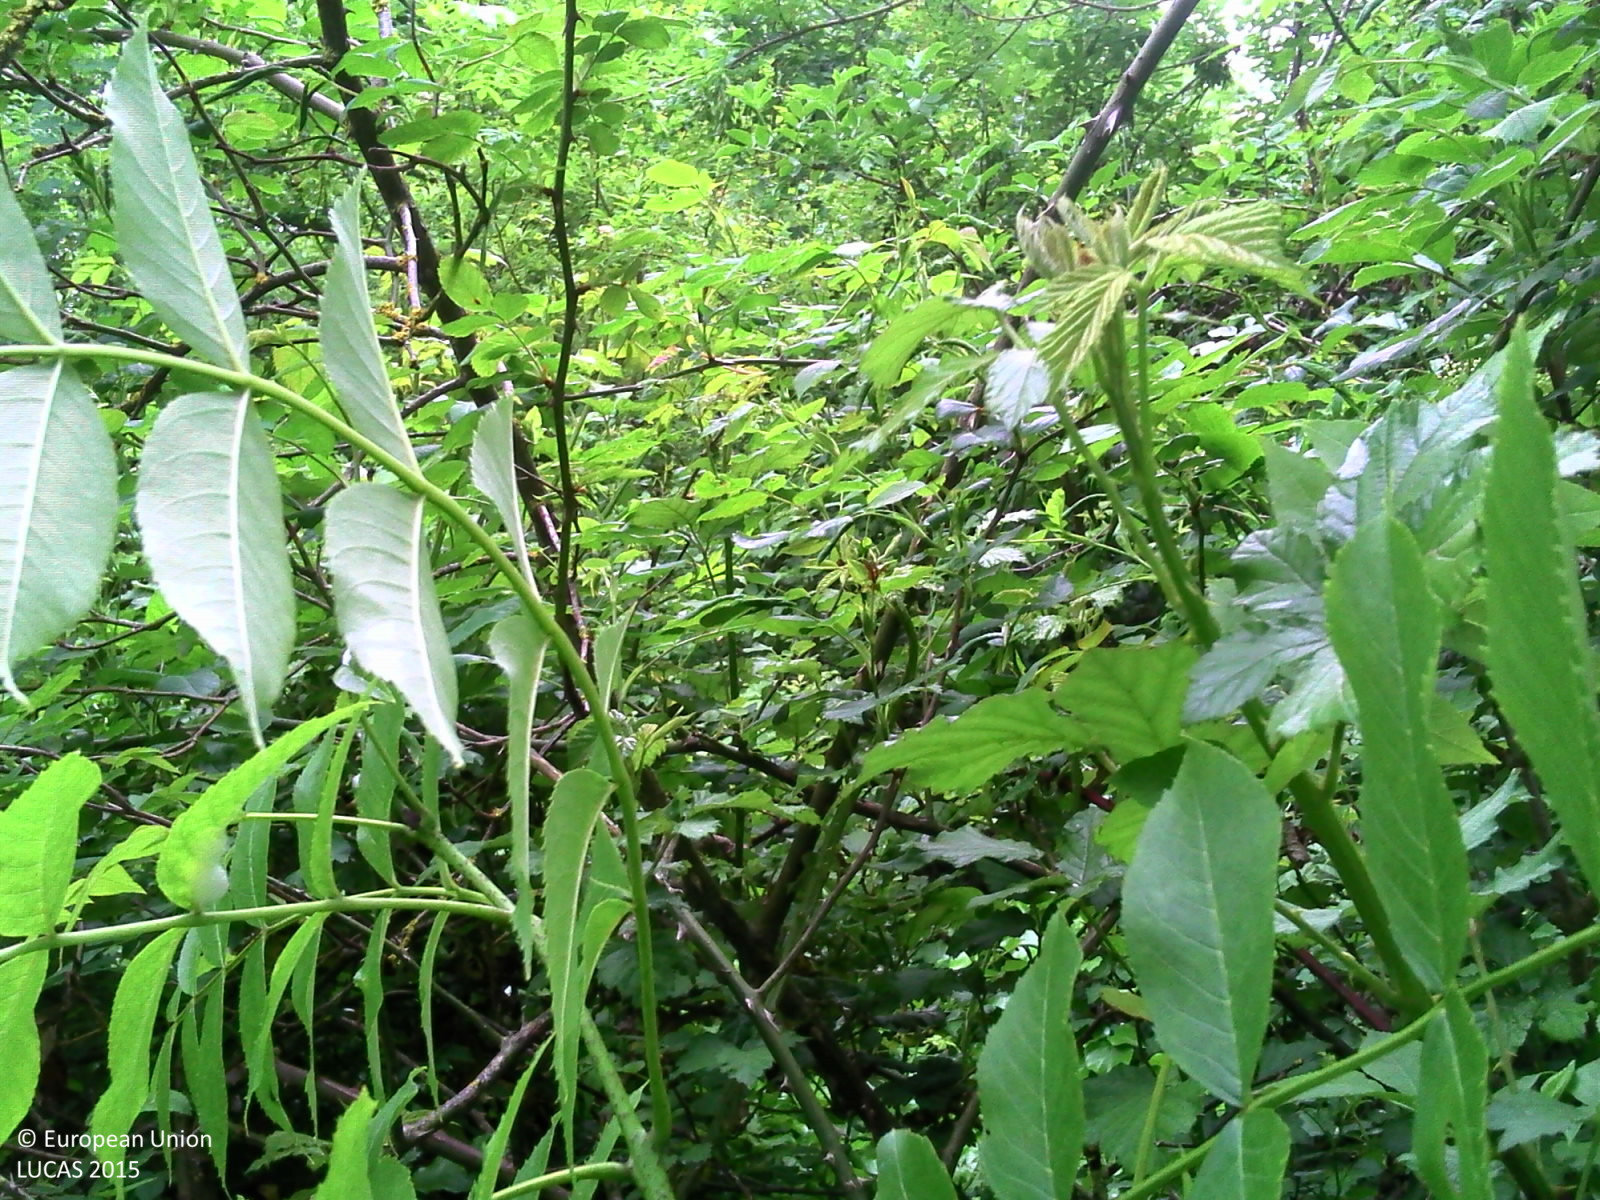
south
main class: Woodland
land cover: Broadleaved woodland
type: mesophytic deciduous forest
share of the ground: > 75 %
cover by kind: broadleaved forest trees 75 %, shrubs 20 %, herbaceous plants 5 %
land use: Semi-natural and natural areas not in use
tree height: > 5 m
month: May
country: FR
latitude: 49.3116
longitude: -0.3652
